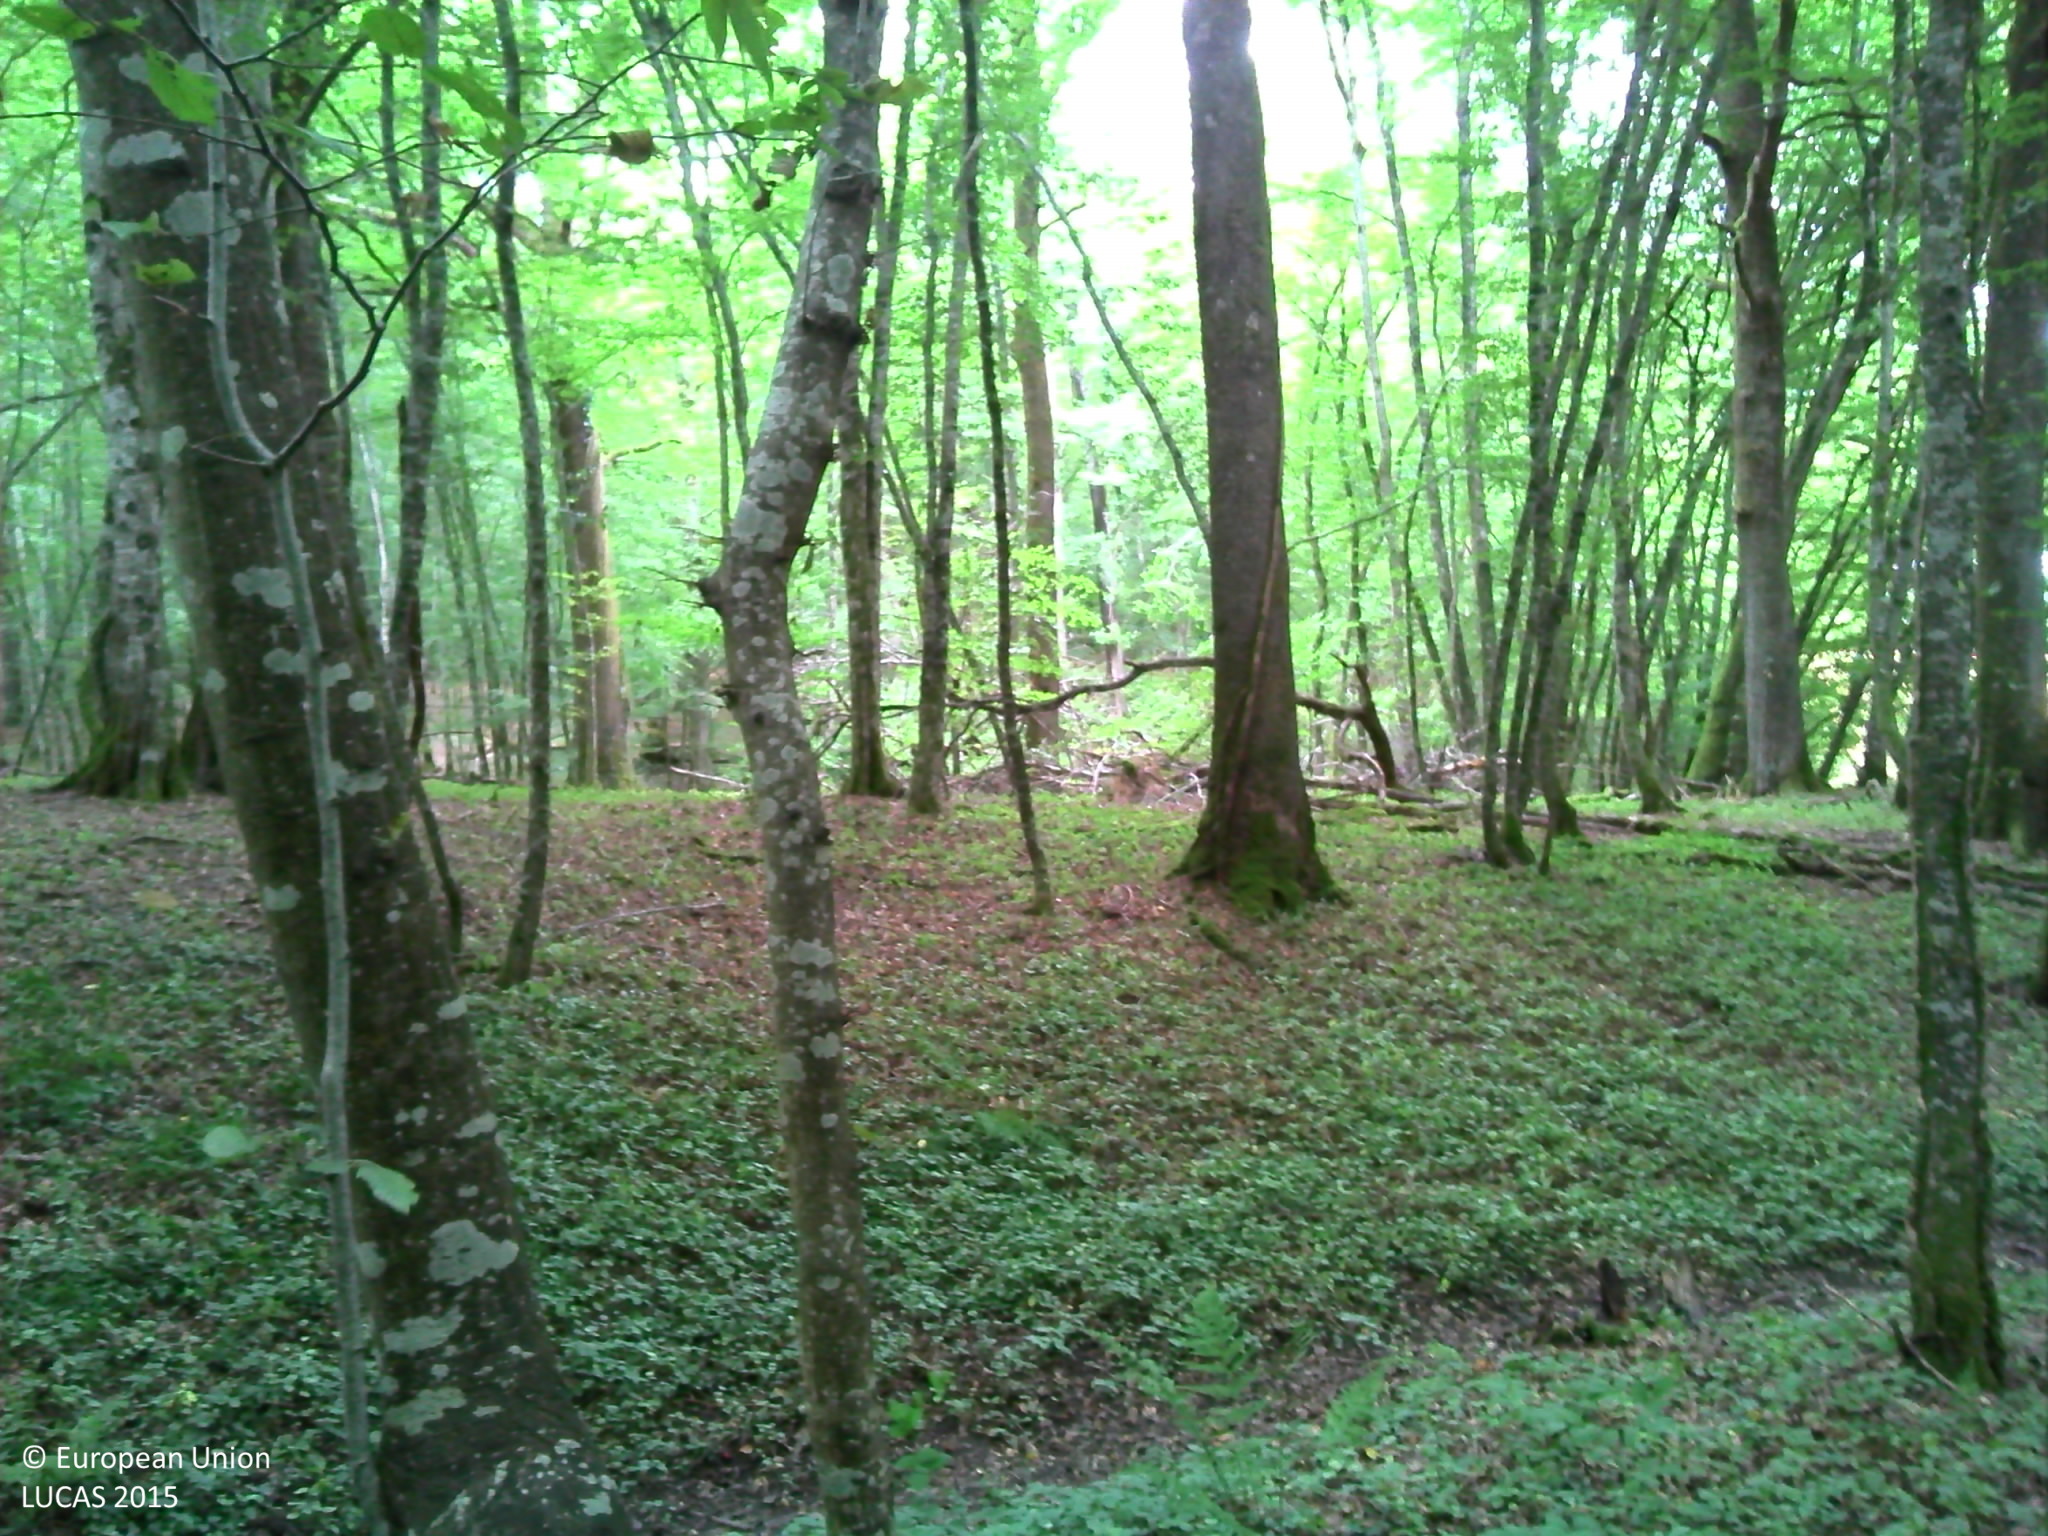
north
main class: Woodland
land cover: Broadleaved woodland
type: mesophytic deciduous forest
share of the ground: > 75 %
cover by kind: broadleaved forest trees 95 %, herbaceous plants 5 %
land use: Forestry
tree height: > 5 m
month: July
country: FR
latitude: 46.5413
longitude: 2.7850
